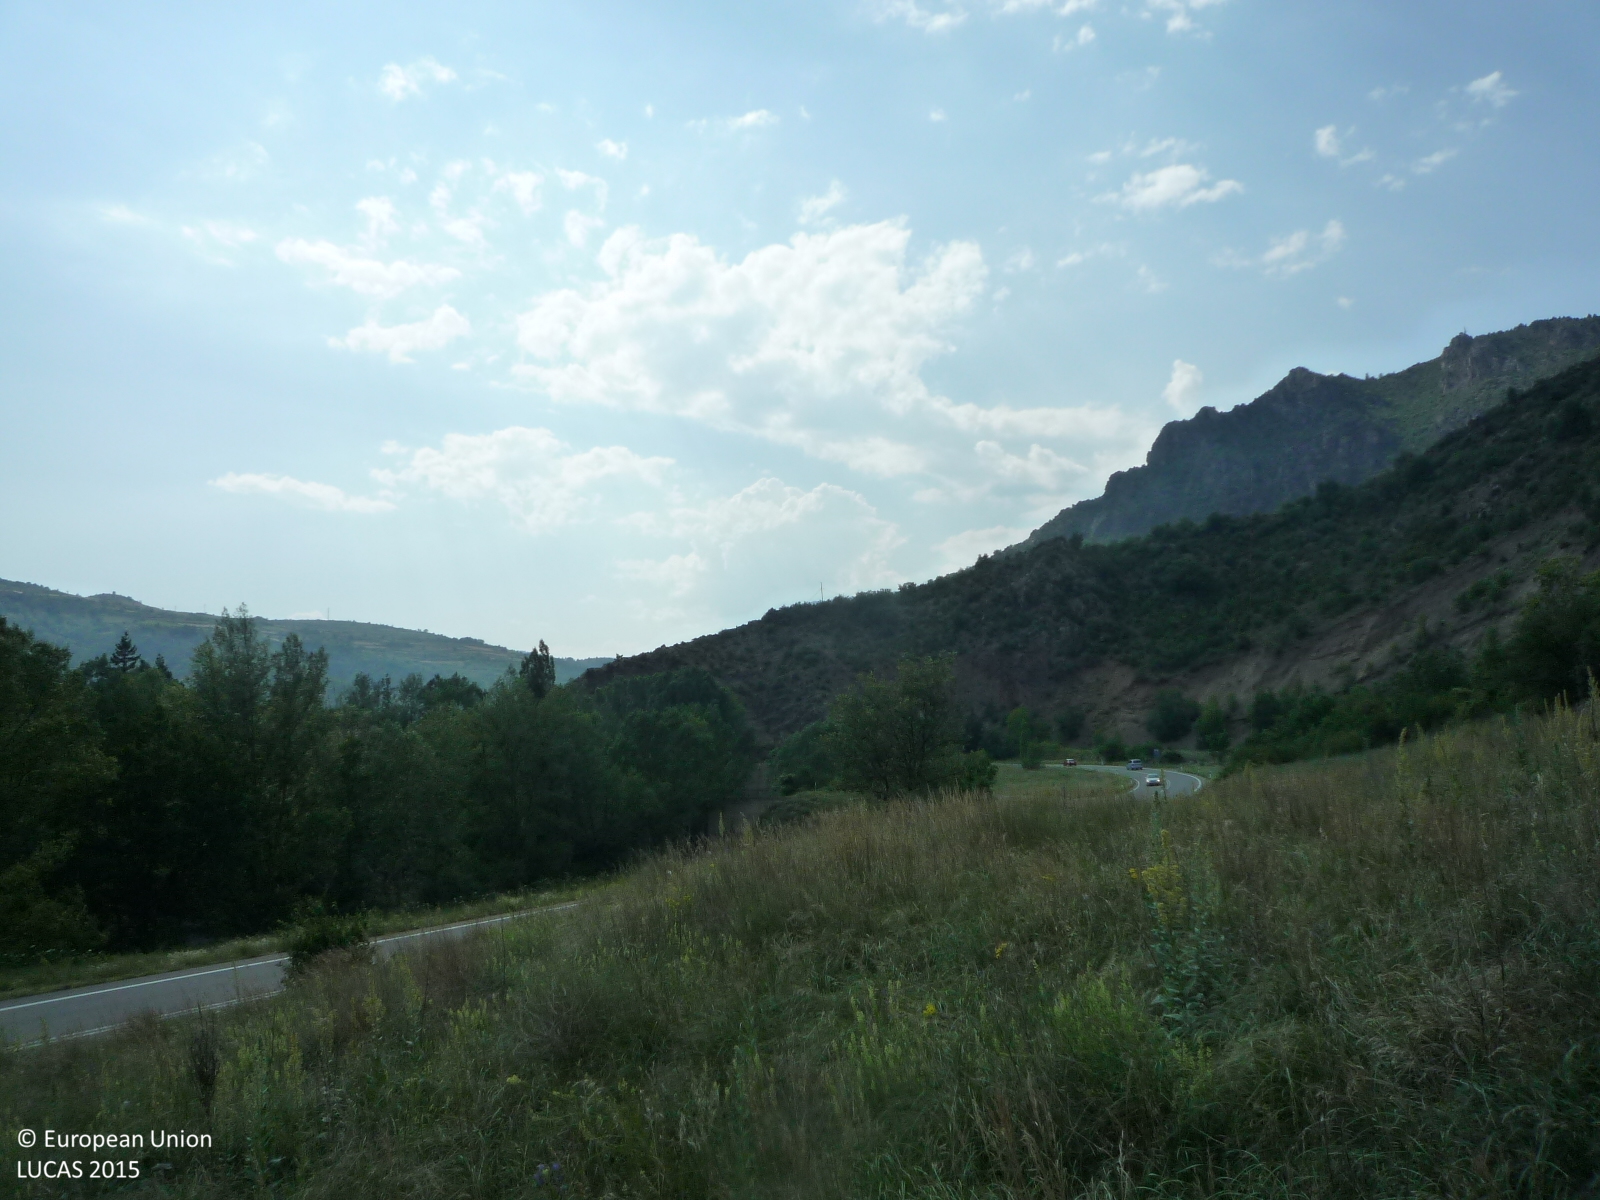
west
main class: Woodland
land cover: Broadleaved woodland
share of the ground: > 75 %
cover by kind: broadleaved forest trees 70 %, shrubs 30 %
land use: Semi-natural and natural areas not in use
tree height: < 5 m
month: June
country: ES
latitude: 42.3648
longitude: 1.6689
